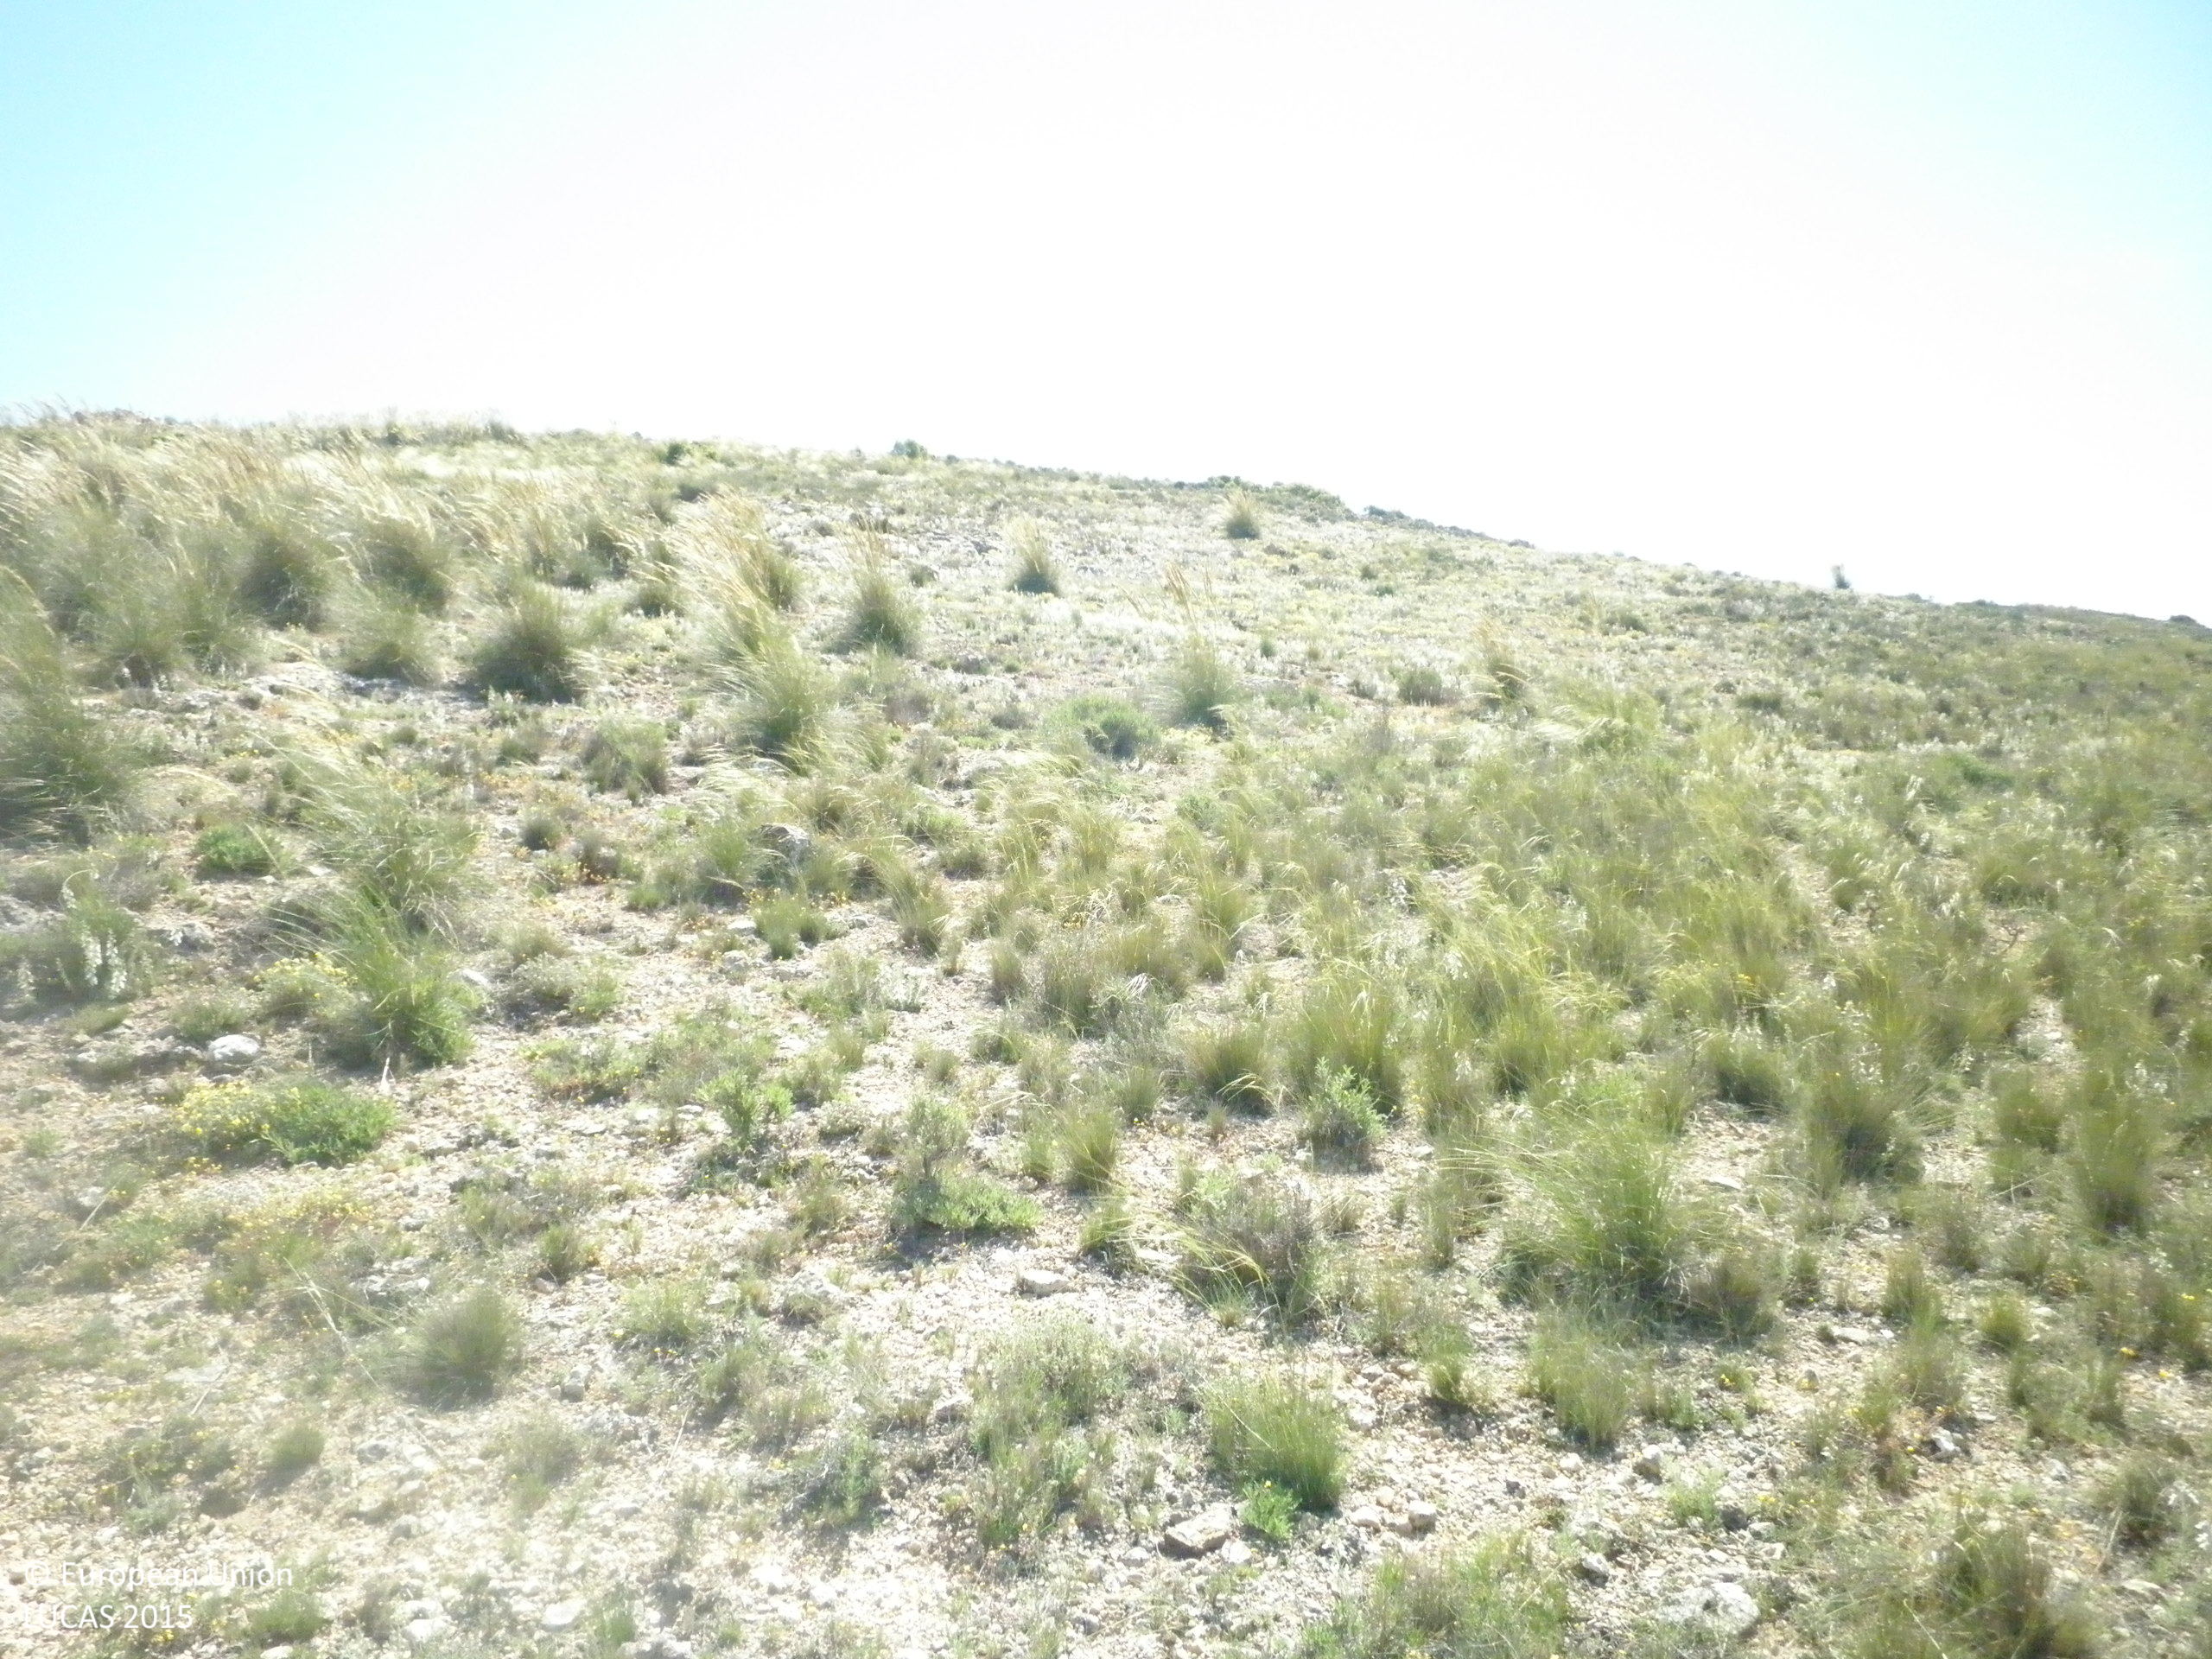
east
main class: Shrubland
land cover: Shrubland without tree cover
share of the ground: > 75 %
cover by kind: unconsolidated bare surface 50 %, herbaceous plants 25 %, shrubs 15 %, consolidated bare surface 10 %
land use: Semi-natural and natural areas not in use
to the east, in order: Shrubland without tree cover; Dry stone walls; Grass margins; Barley
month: May
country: ES
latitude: 39.7072
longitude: -2.7421
